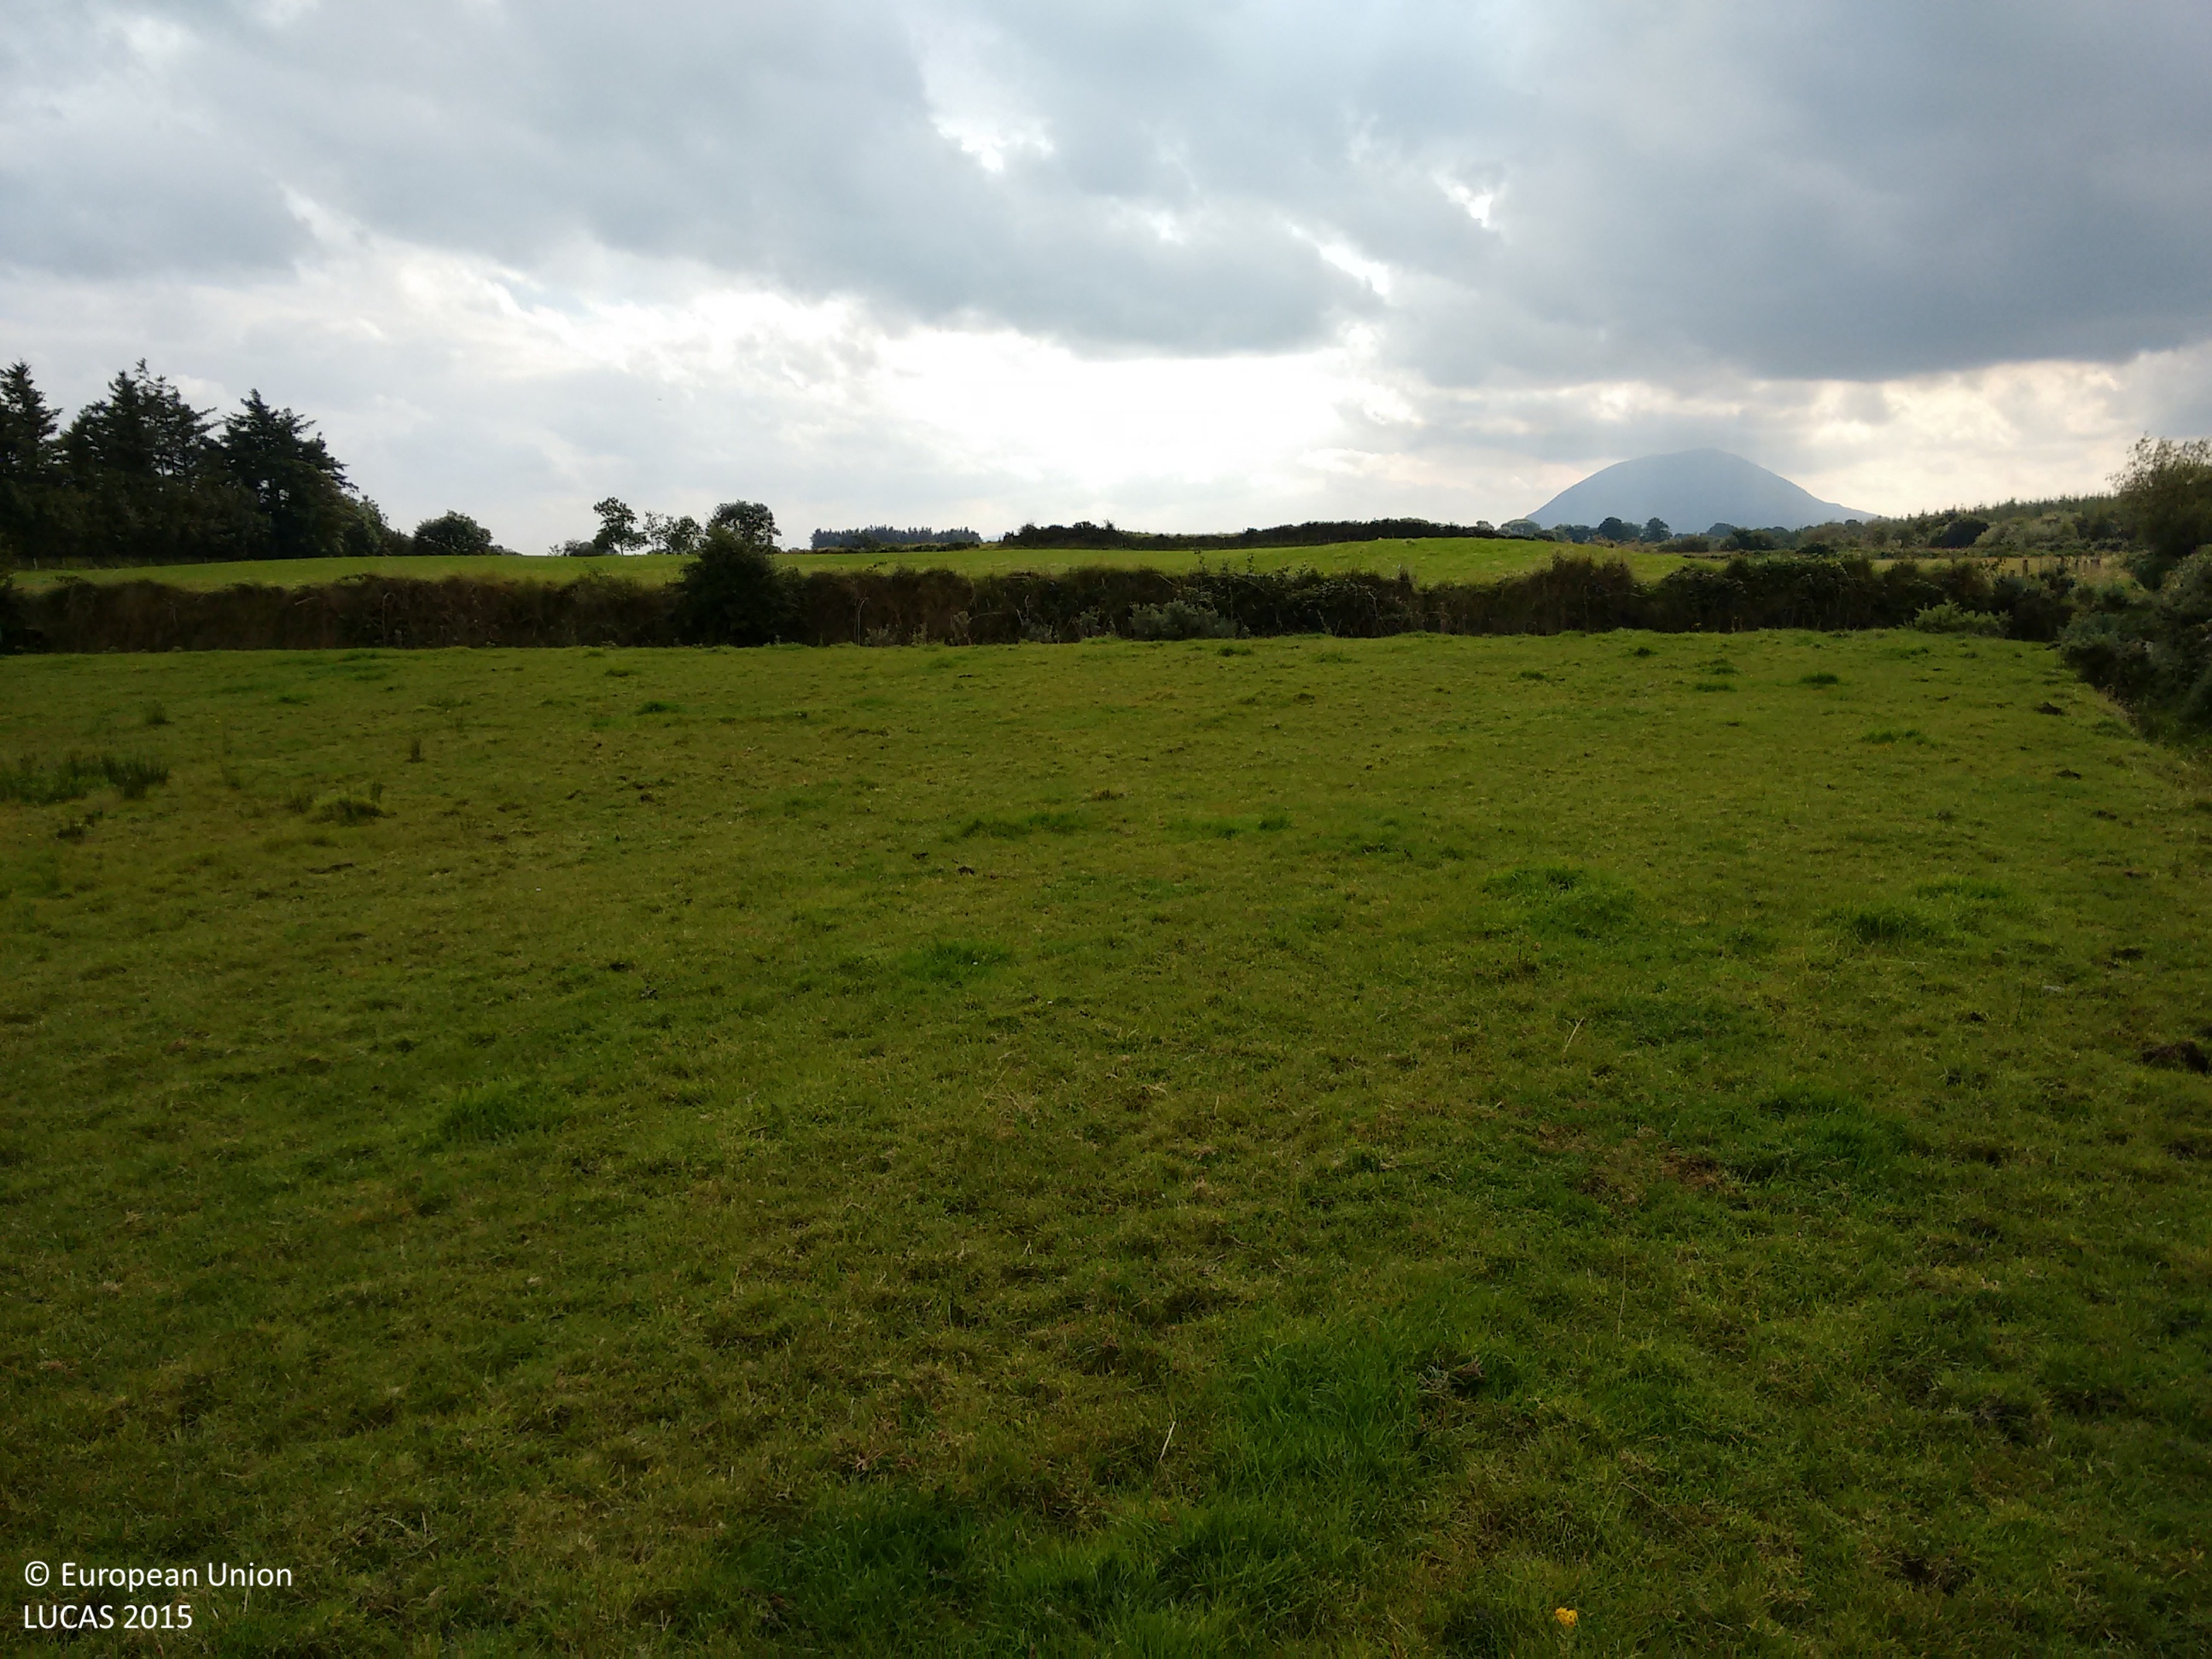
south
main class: Woodland
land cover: Spruce dominated coniferous woodland
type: exotic forest
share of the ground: > 75 %
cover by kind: coniferous forest trees 100 %
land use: Forestry
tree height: > 5 m
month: September
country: IE
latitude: 54.1365
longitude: -9.3419
